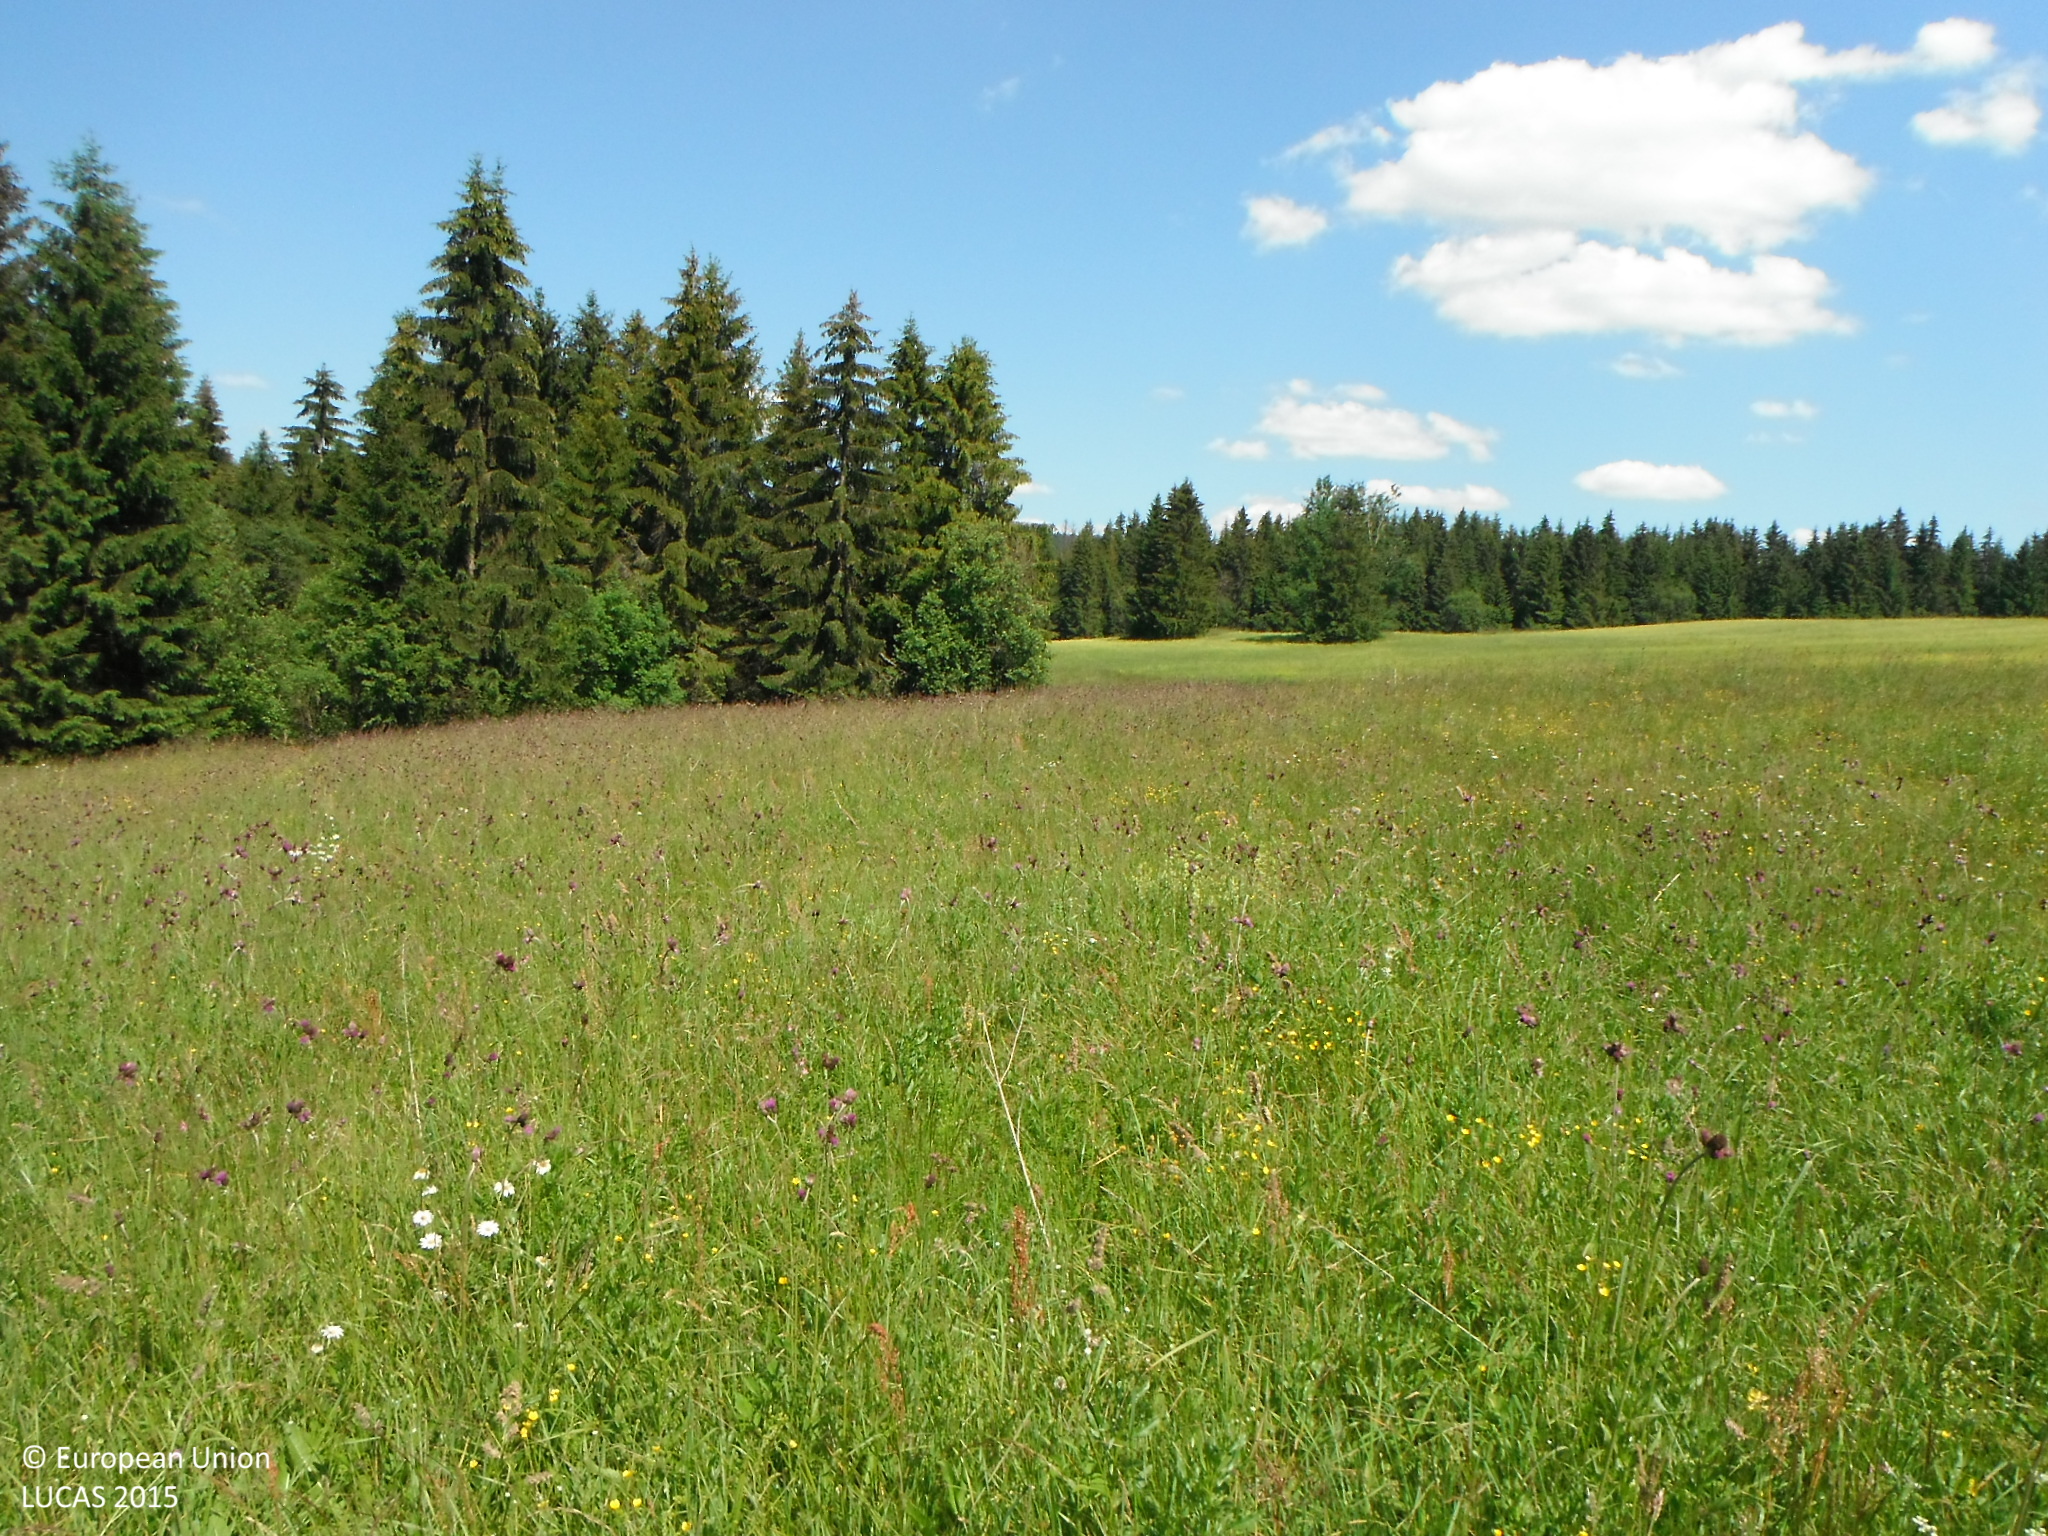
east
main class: Grassland
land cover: Grassland without tree/shrub cover
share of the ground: > 75 %
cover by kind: herbaceous plants 100 %
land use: Agriculture (excluding fallow land and kitchen gardens)
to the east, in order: Grassland without tree/shrub cover; Tracks; Other leguminous and mixtures for fodder; Spruce dominated mixed woodland; Other leguminous and mixtures for fodder
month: July
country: SK
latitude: 49.4696
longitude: 19.3955
